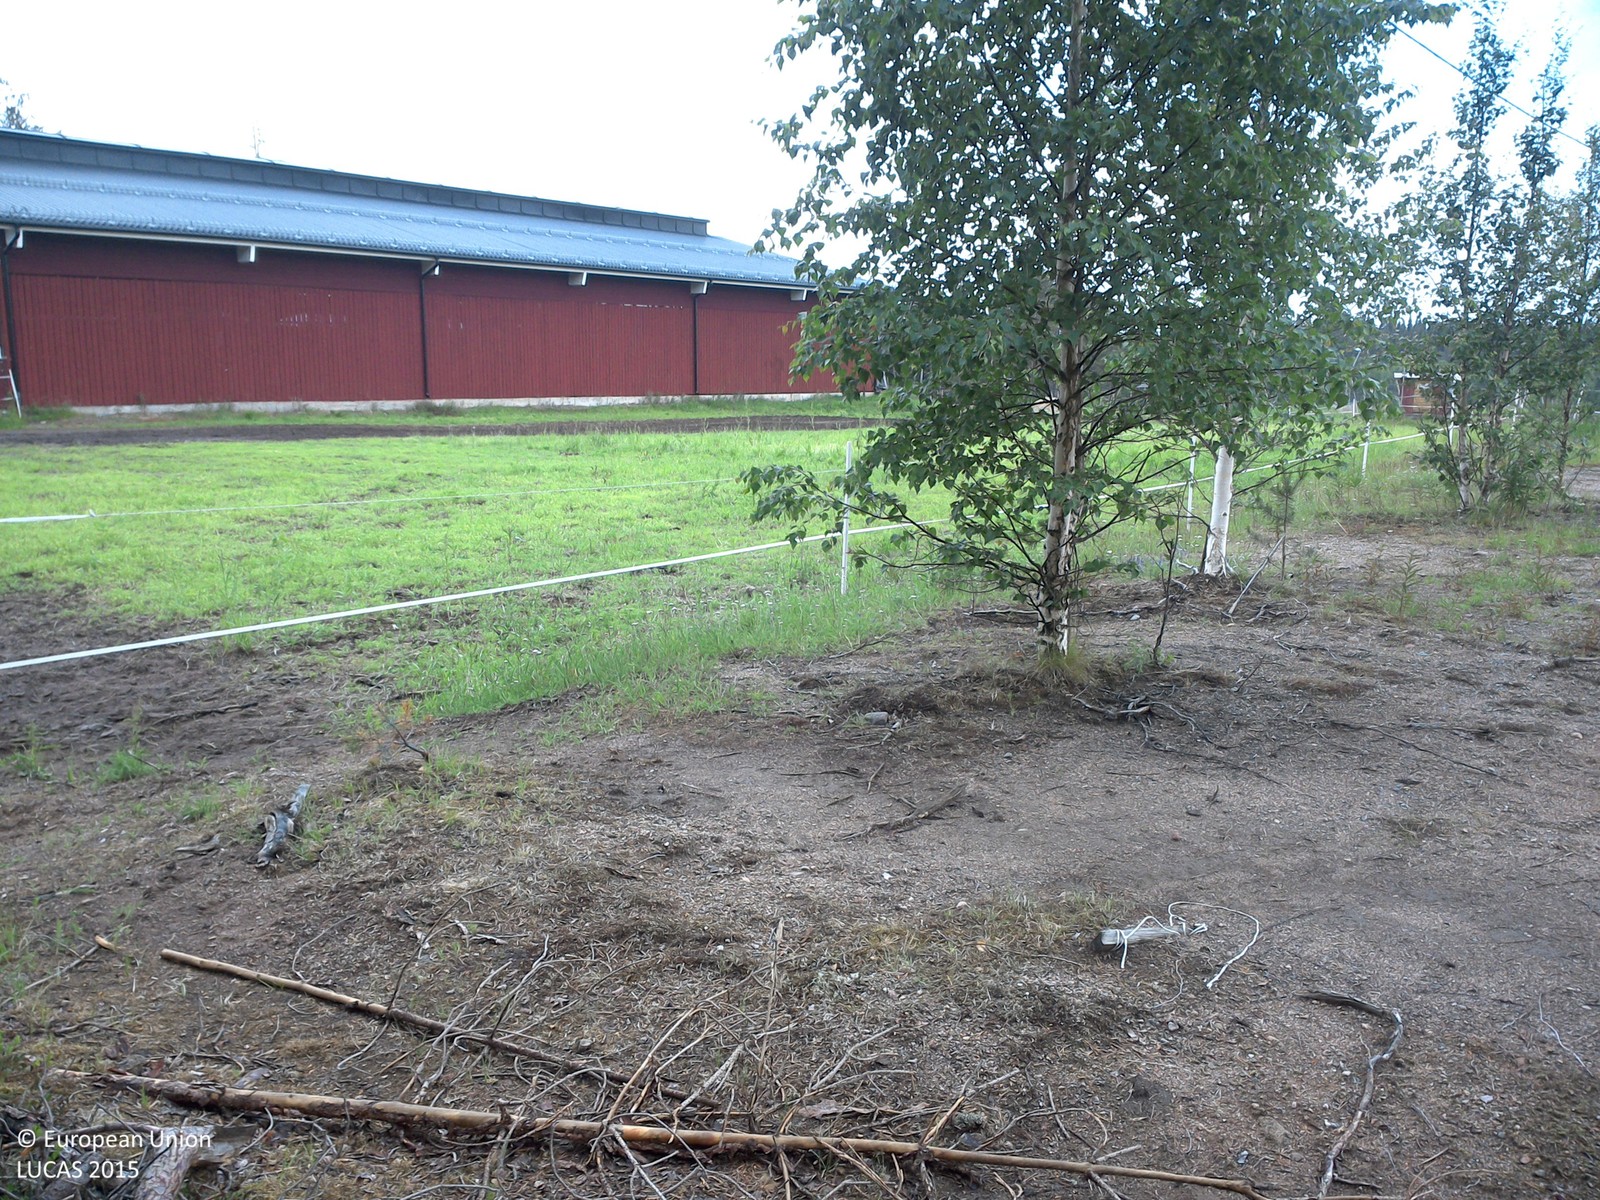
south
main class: Woodland
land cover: Pine dominated coniferous woodland
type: boreal forest
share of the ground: 25 - 50 %
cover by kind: shrubs 55 %, coniferous forest trees 45 %
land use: Forestry
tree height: > 5 m
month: July
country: SE
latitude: 66.9790
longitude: 23.7989
